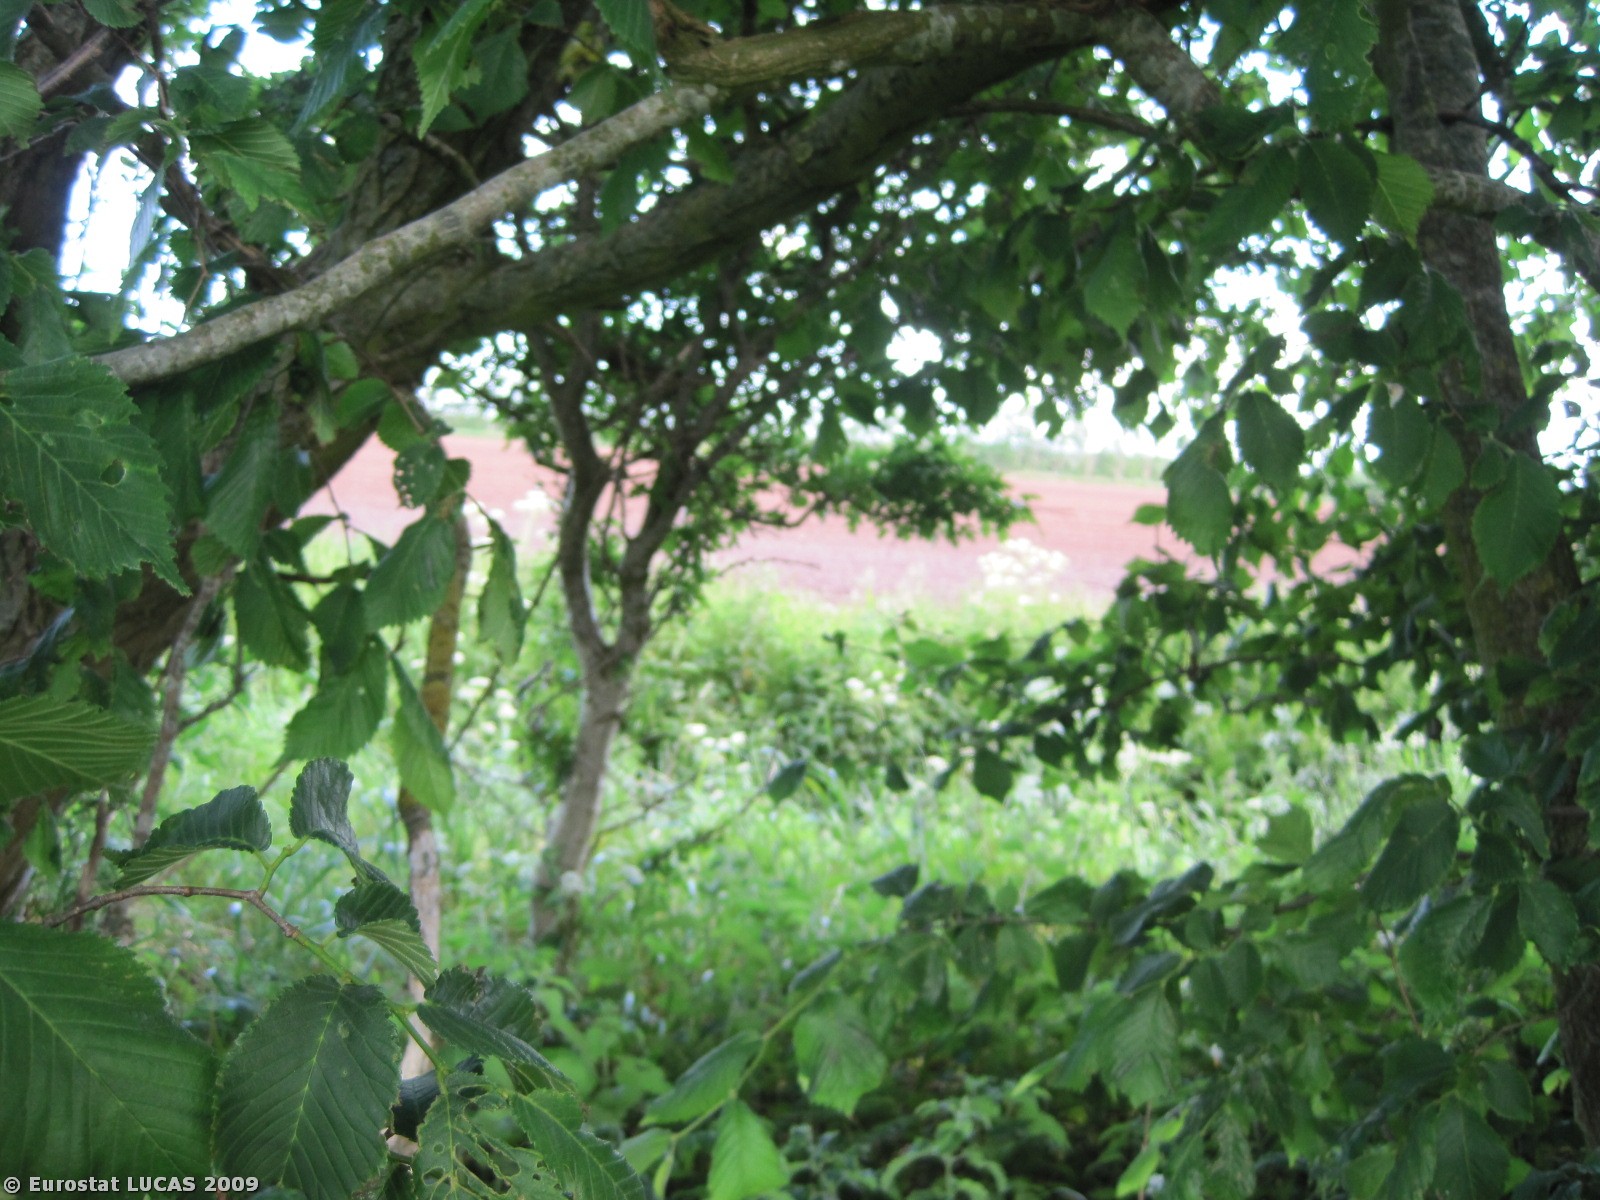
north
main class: Woodland
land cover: Broadleaved woodland
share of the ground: > 75 %
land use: Agriculture (excluding fallow land and kitchen gardens)
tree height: > 5 m
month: June
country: DK
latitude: 57.1943
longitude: 9.7852
